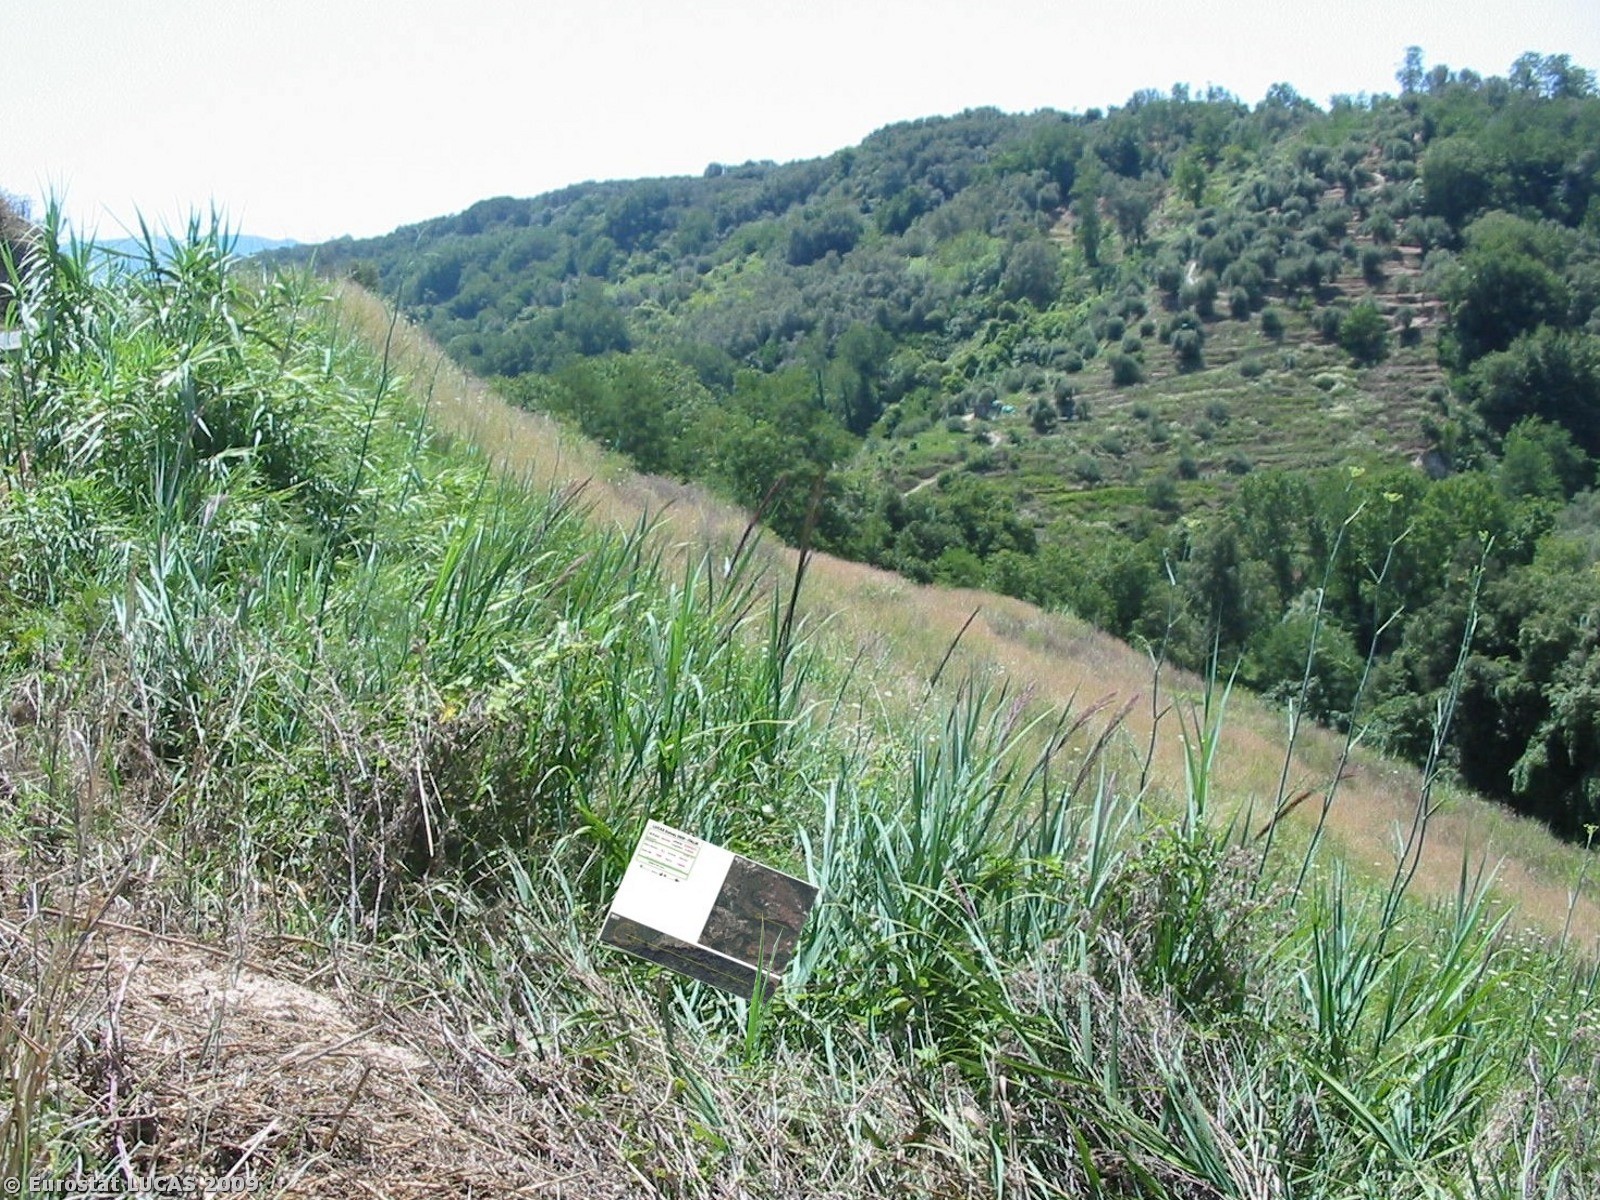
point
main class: Shrubland
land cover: Shrubland without tree cover
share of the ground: > 75 %
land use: Fallow land
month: July
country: IT
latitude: 38.4807
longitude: 16.0748
